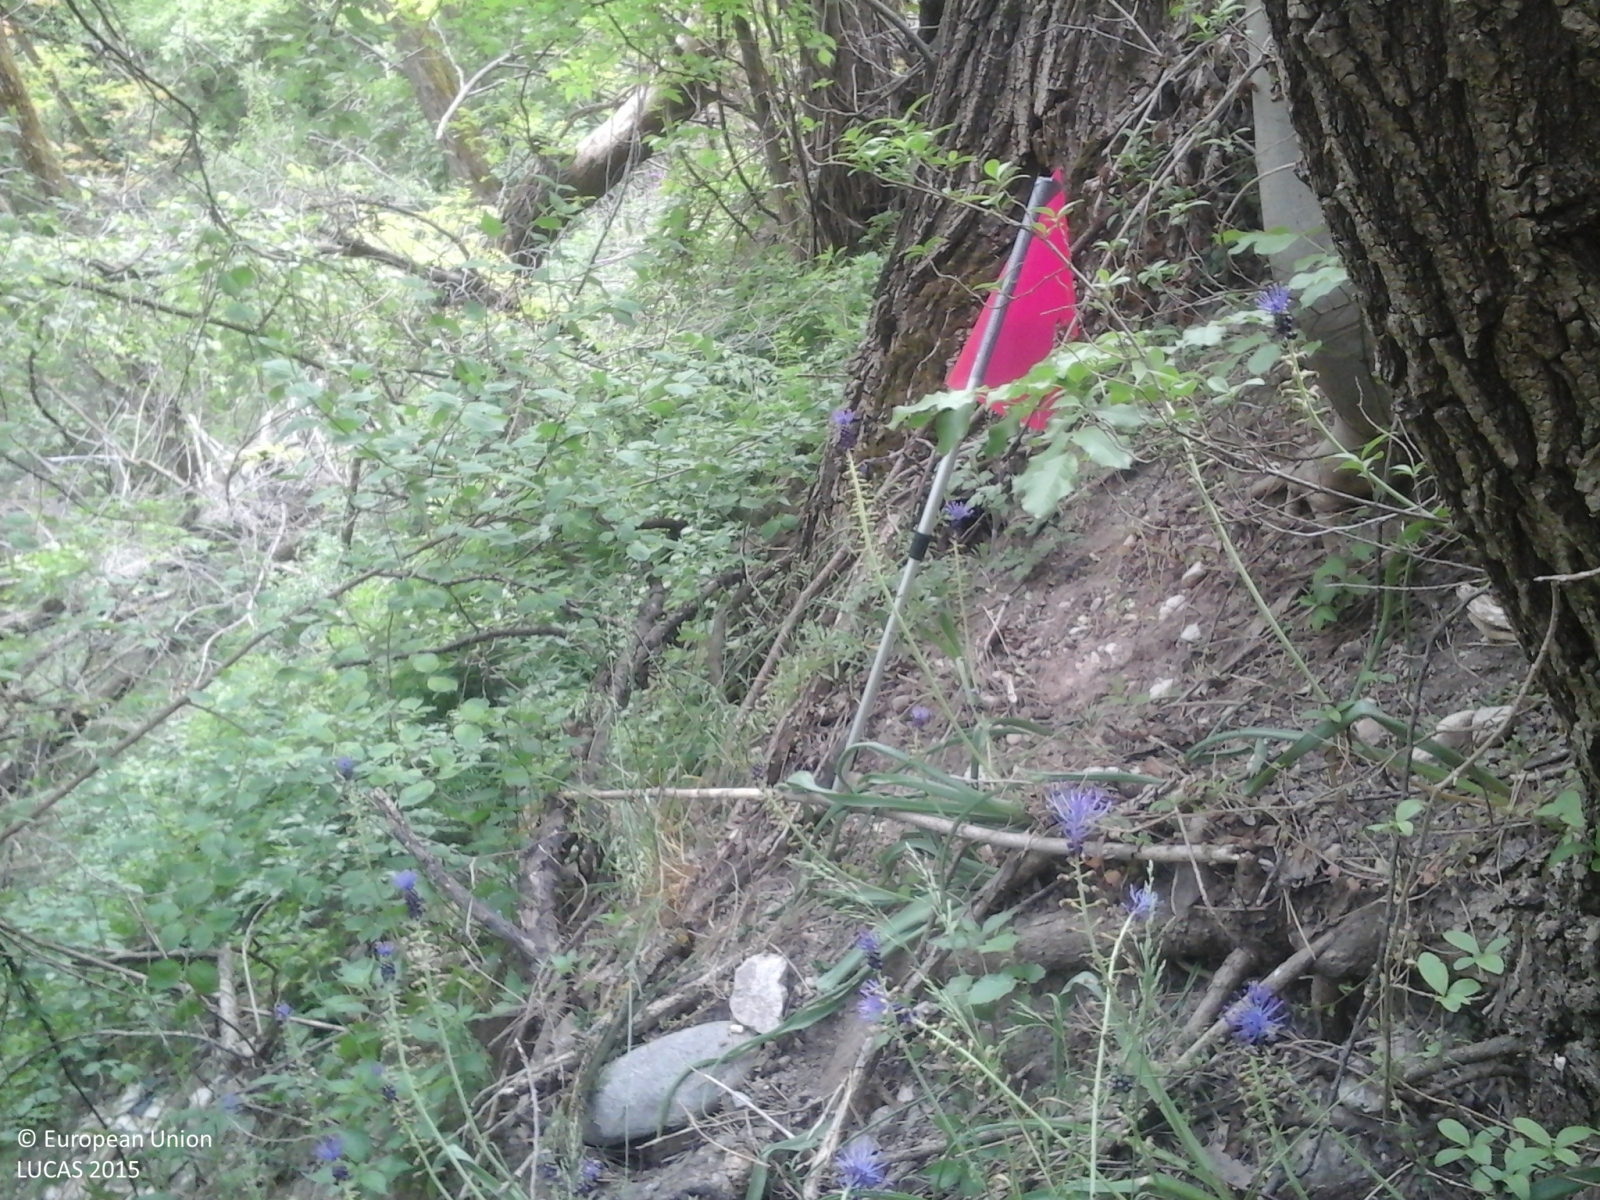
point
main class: Woodland
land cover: Broadleaved woodland
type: thermophilous deciduous forest
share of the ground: > 75 %
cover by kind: broadleaved forest trees 100 %
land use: Forestry
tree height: > 5 m
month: April
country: IT
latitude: 46.2737
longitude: 11.0756
